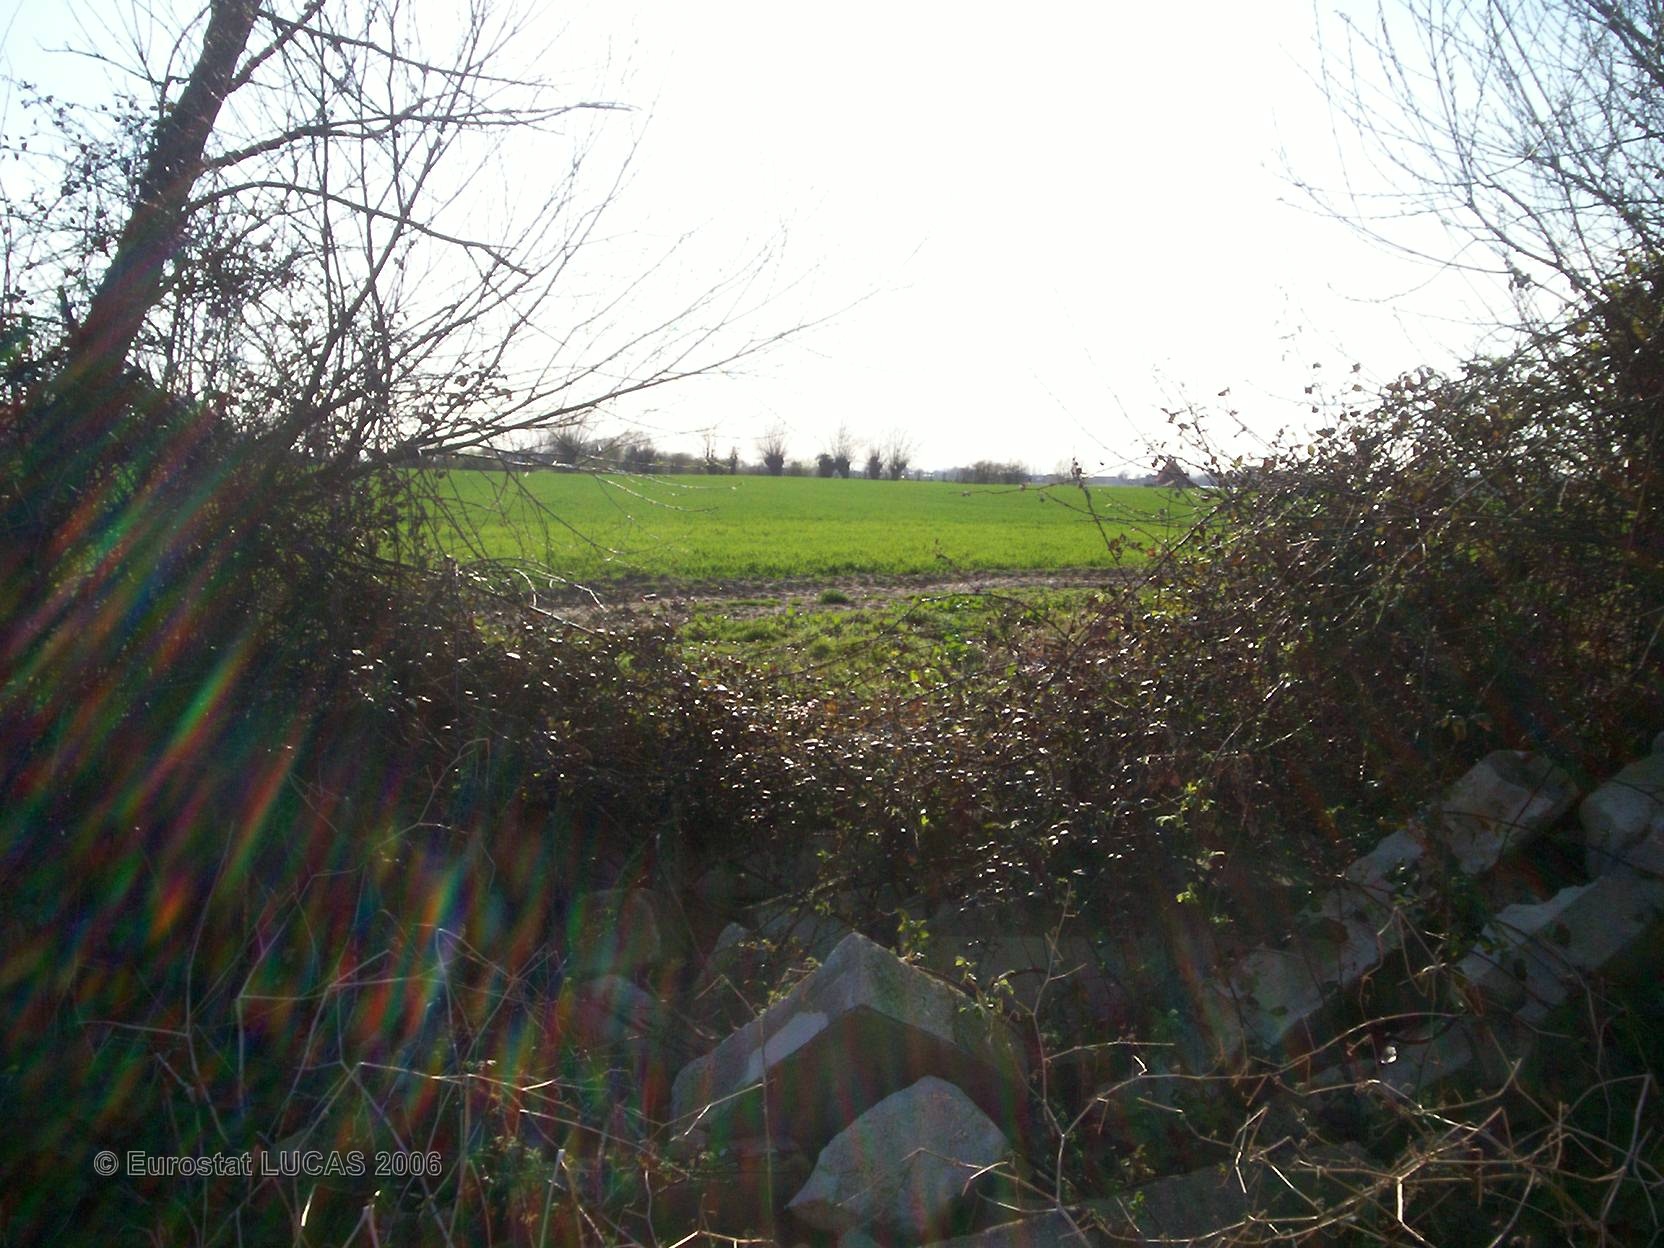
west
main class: Grassland
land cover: Grassland with sparse tree/shrub cover
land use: Agriculture (excluding fallow land and kitchen gardens)
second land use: Residential
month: April
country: FR
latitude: 50.8760
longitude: 2.4976
